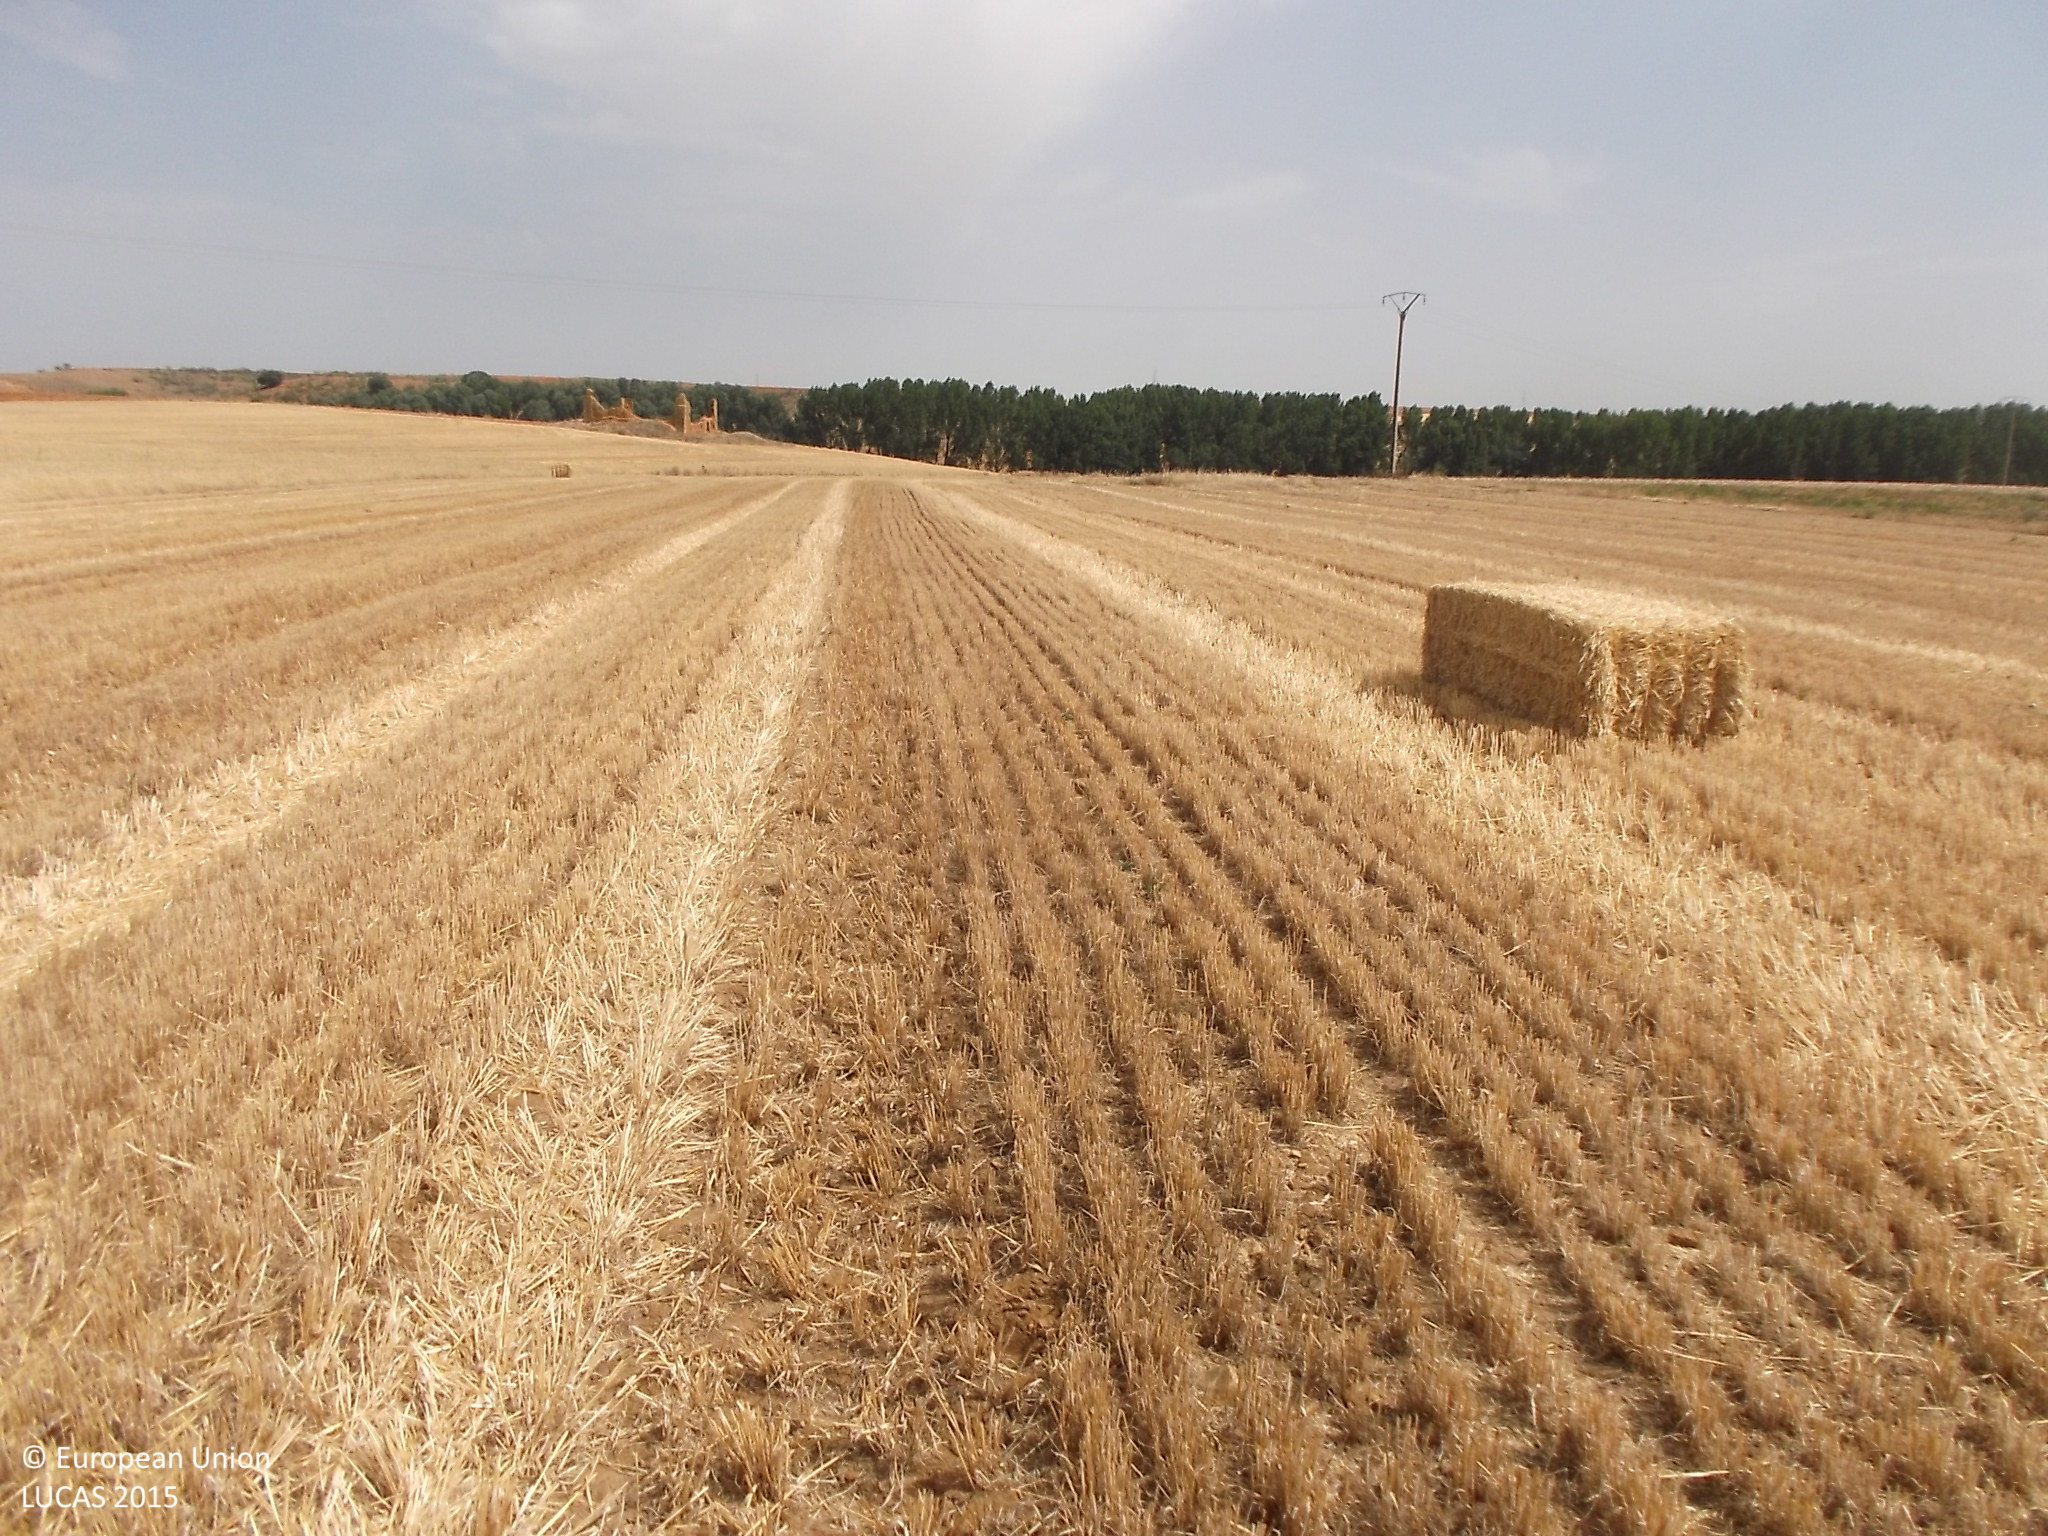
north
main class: Cropland
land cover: Barley
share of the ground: < 10 %
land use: Agriculture (excluding fallow land and kitchen gardens)
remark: Harvested field
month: July
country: ES
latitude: 41.6095
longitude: -5.5516
